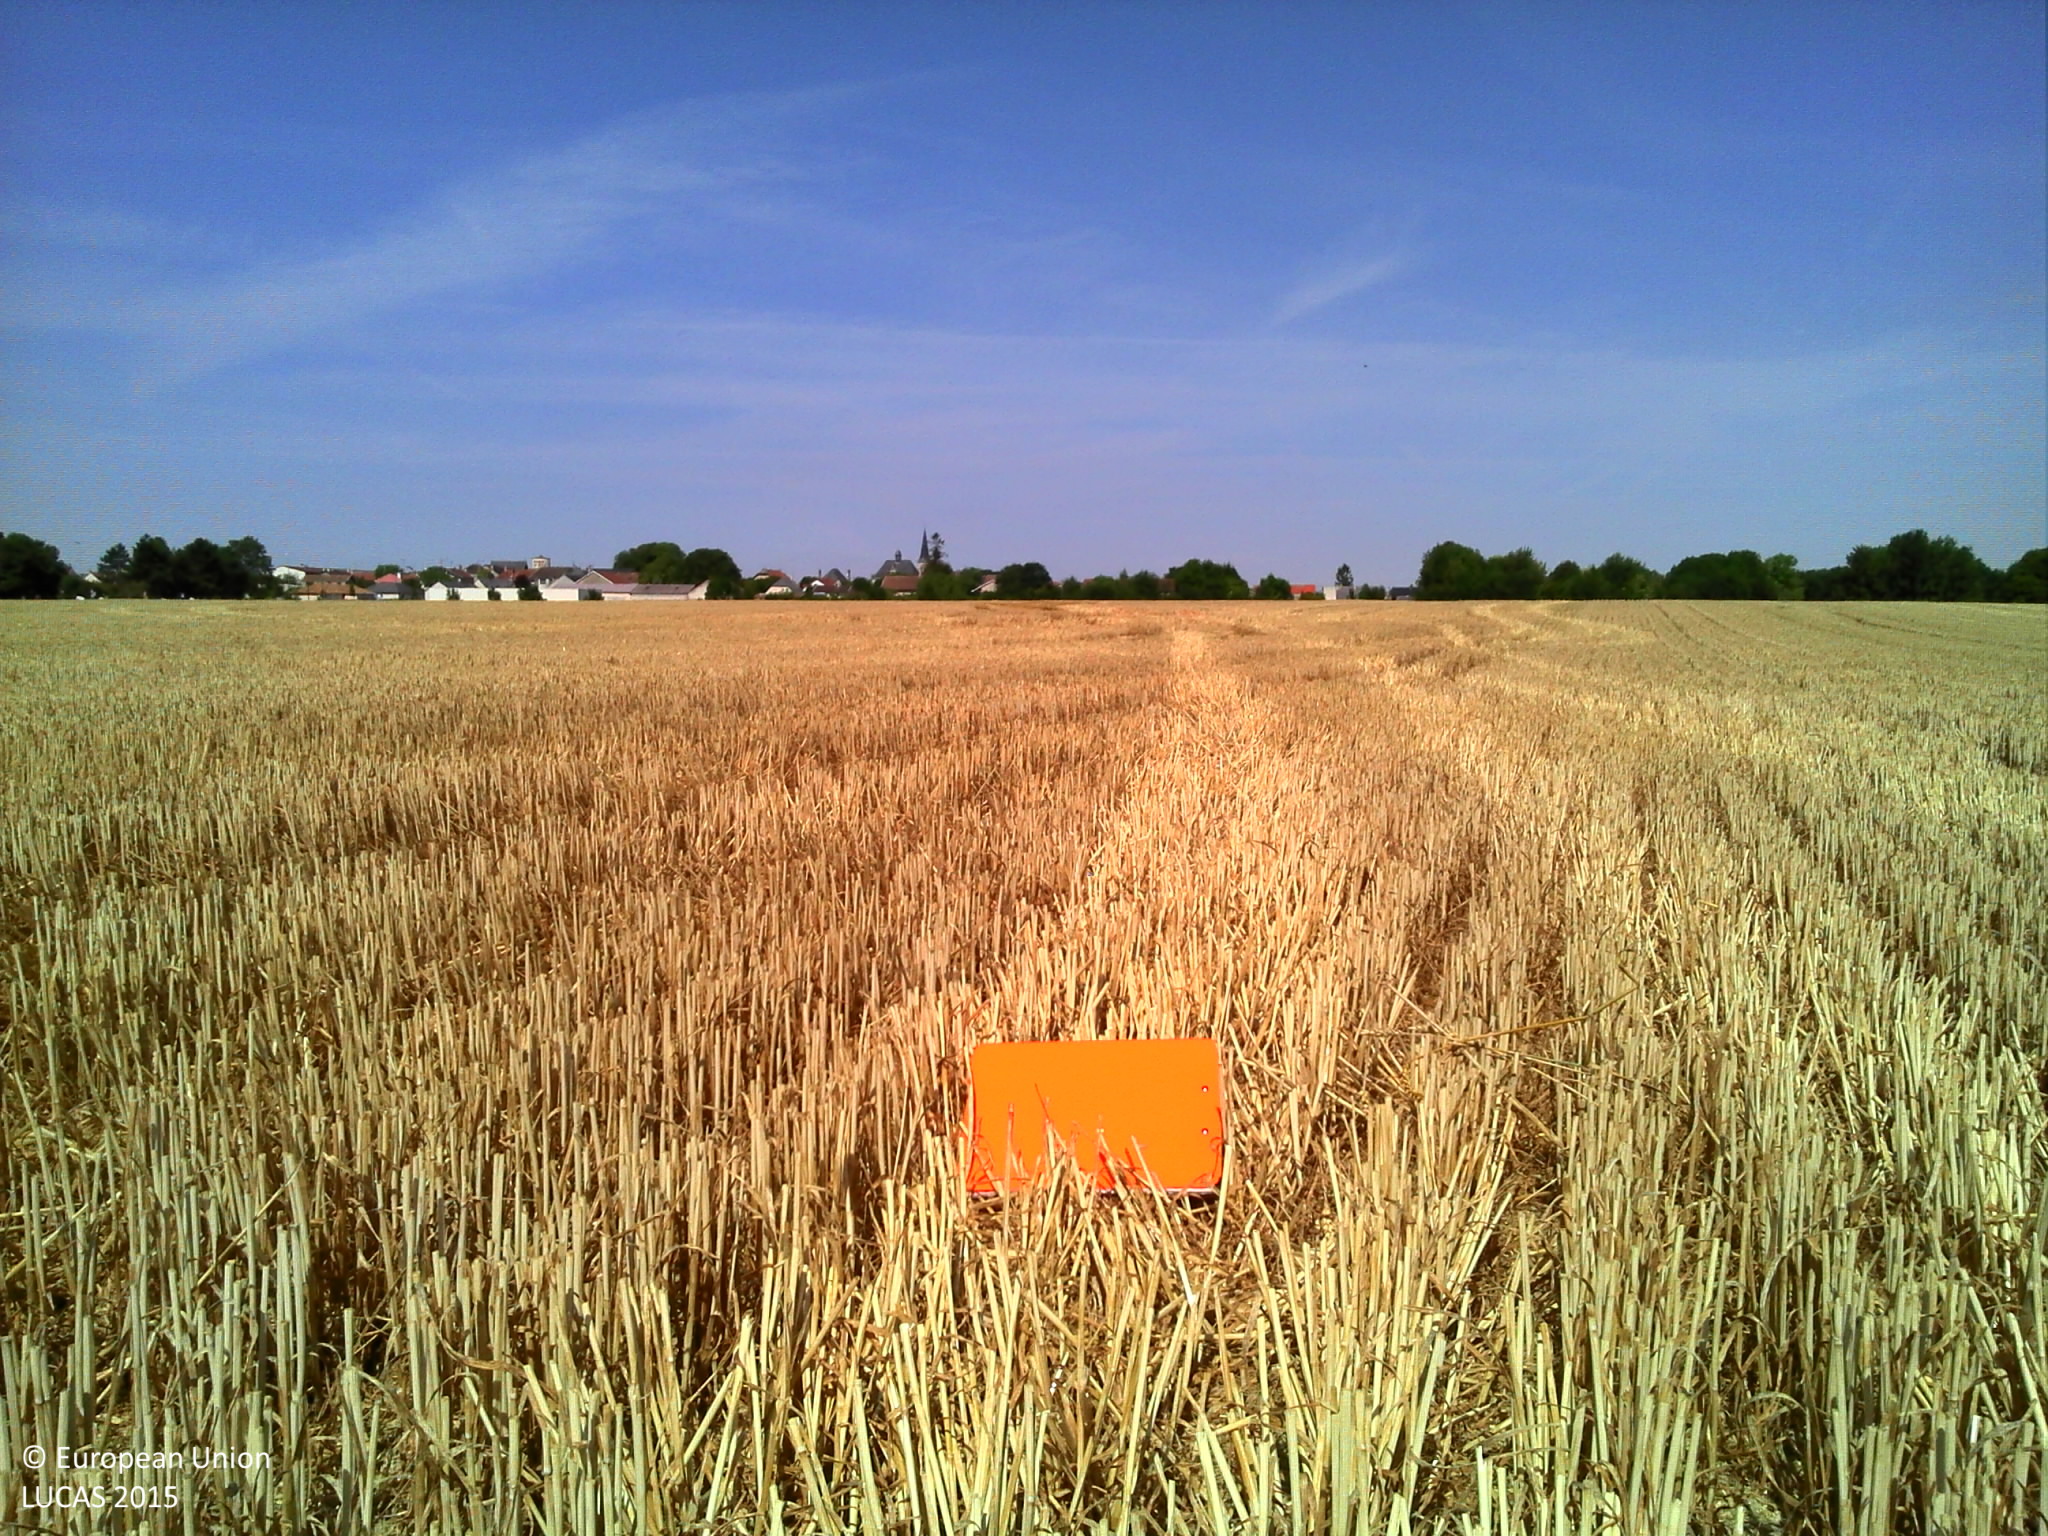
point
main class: Cropland
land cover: Common wheat
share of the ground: > 75 %
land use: Agriculture (excluding fallow land and kitchen gardens)
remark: Harvested field
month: August
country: FR
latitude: 49.1708
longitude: 4.1938
